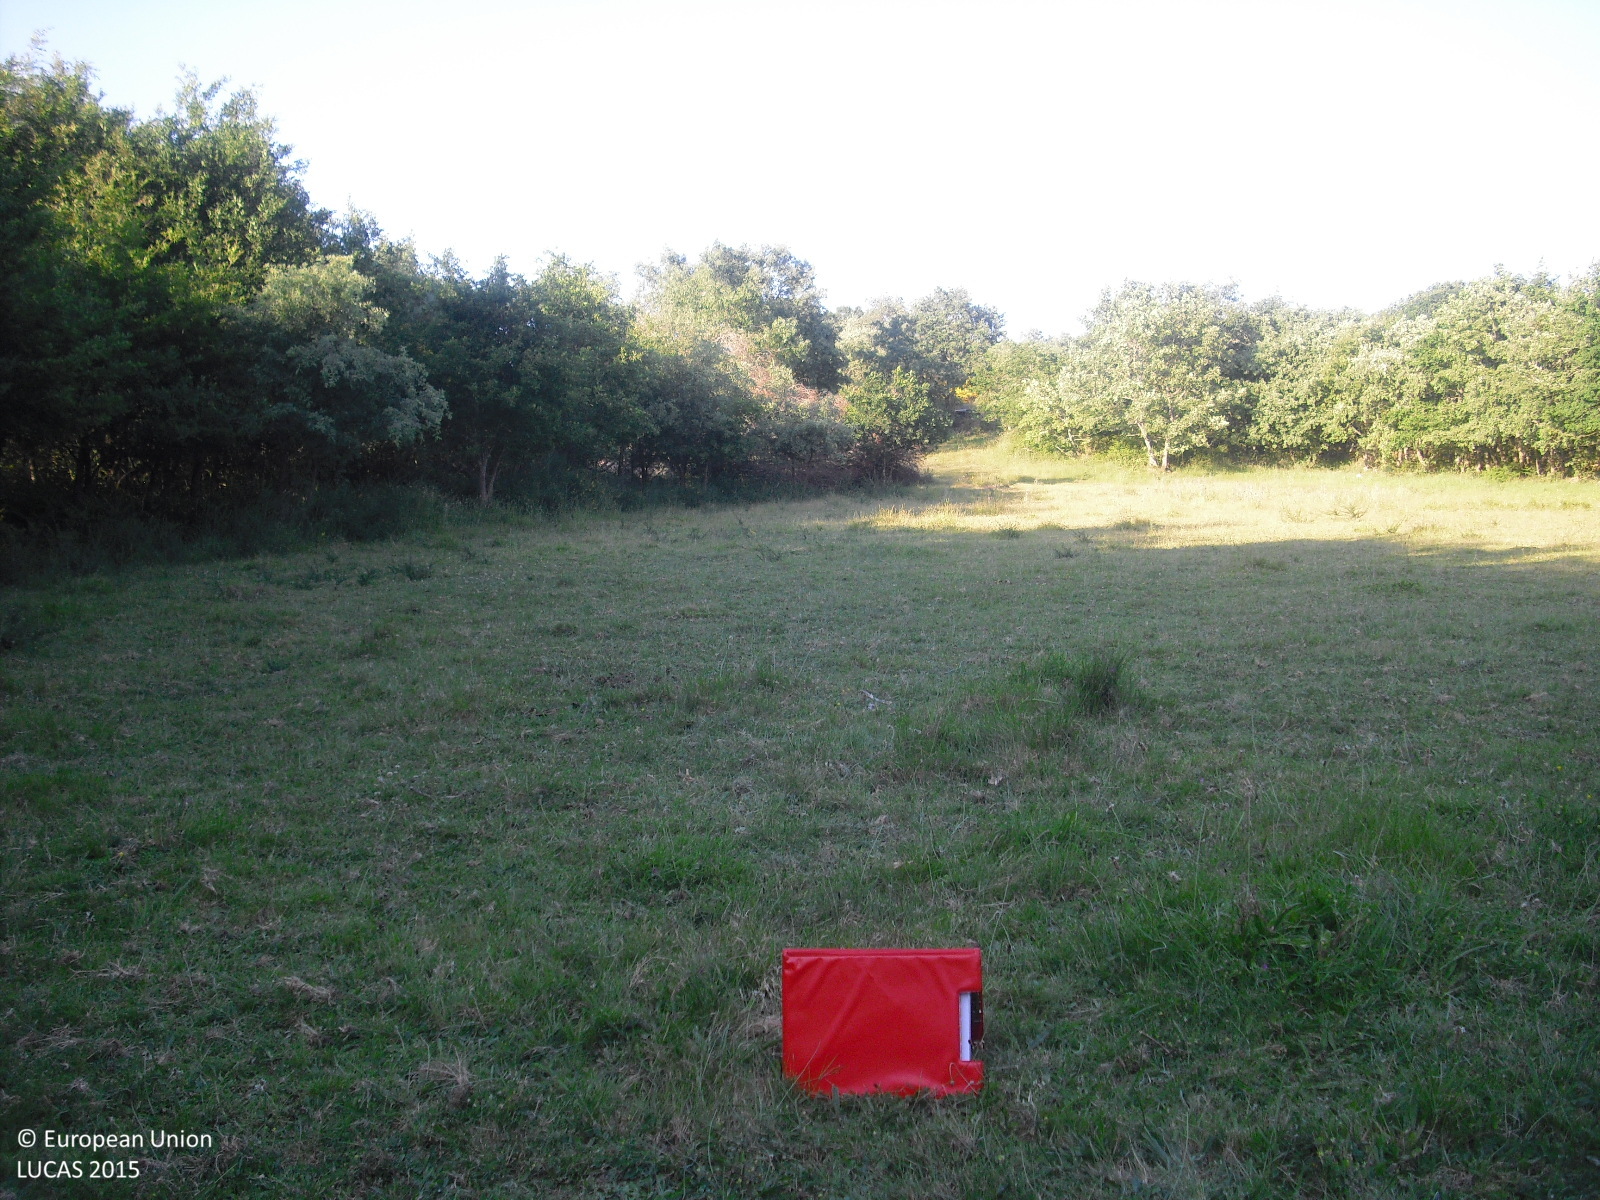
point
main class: Grassland
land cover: Grassland without tree/shrub cover
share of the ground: > 75 %
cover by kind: herbaceous plants 100 %
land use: Agriculture (excluding fallow land and kitchen gardens)
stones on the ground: < 10 %
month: May
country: ES
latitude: 42.2375
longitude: -7.7278
